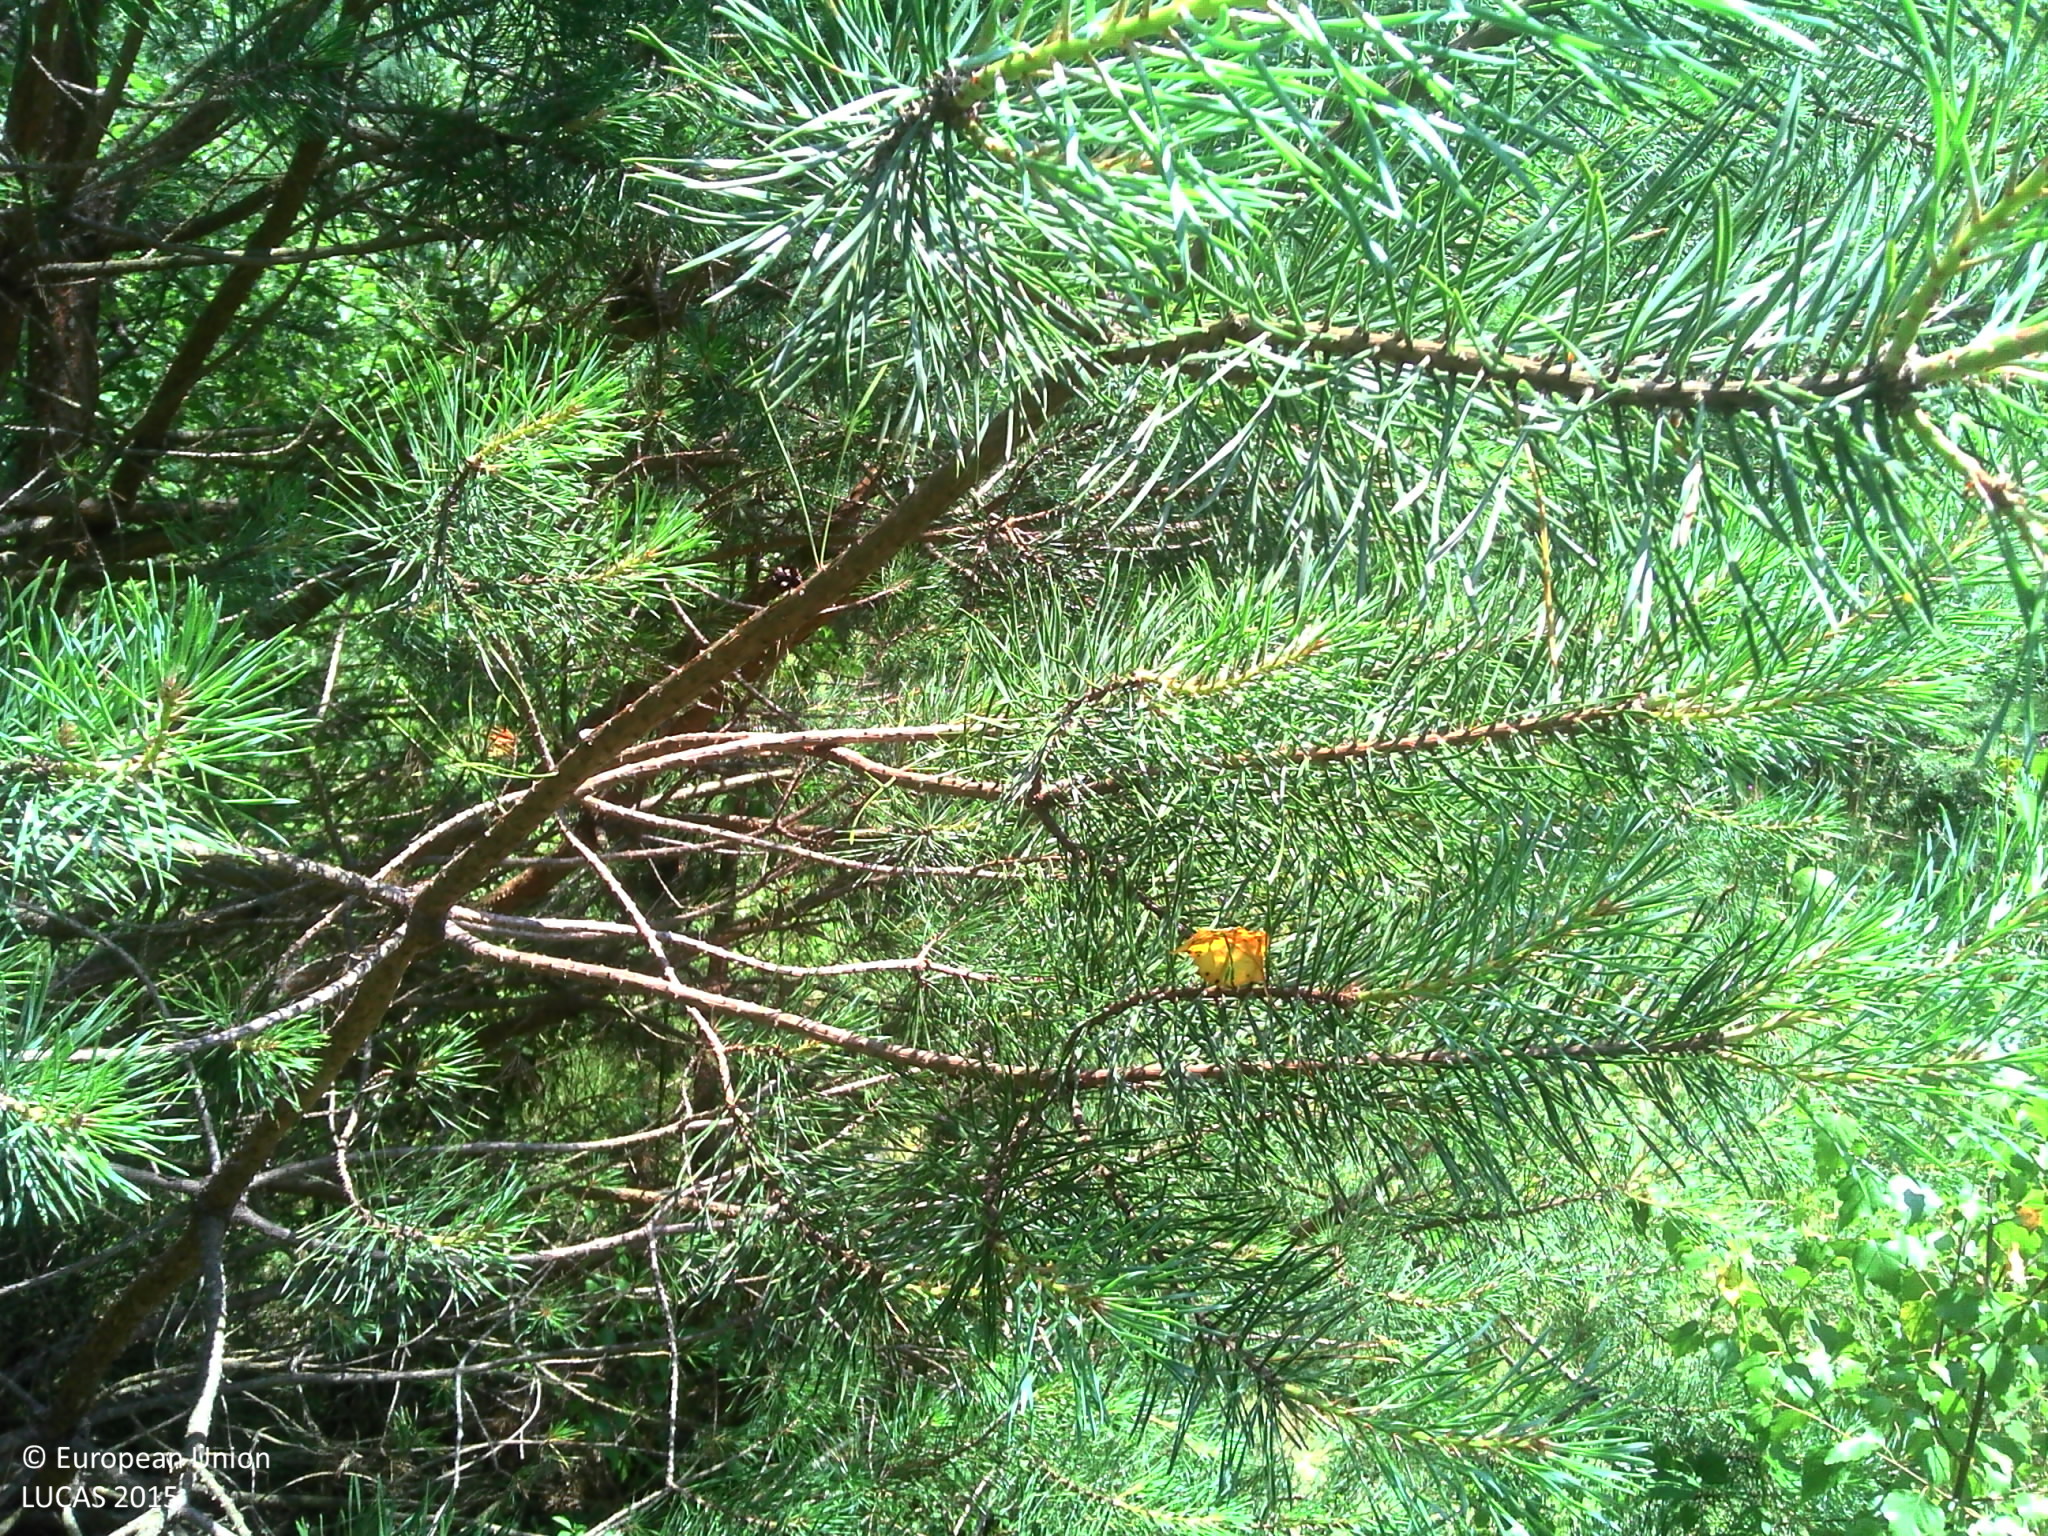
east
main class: Woodland
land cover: Pine dominated mixed woodland
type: thermophilous deciduous forest
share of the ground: > 75 %
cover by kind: coniferous forest trees 30 %, broadleaved forest trees 30 %, herbaceous plants 20 %, unconsolidated bare surface 20 %
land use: Forestry
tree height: > 5 m
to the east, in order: Pine dominated mixed woodland; Tracks; Lines of trees; Grassland without tree/shrub cover; Electric lines; Grassland without tree/shrub cover; Grassland with sparse tree/shrub cover; Broadleaved woodland
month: June
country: FR
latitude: 47.6622
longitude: 2.0124
